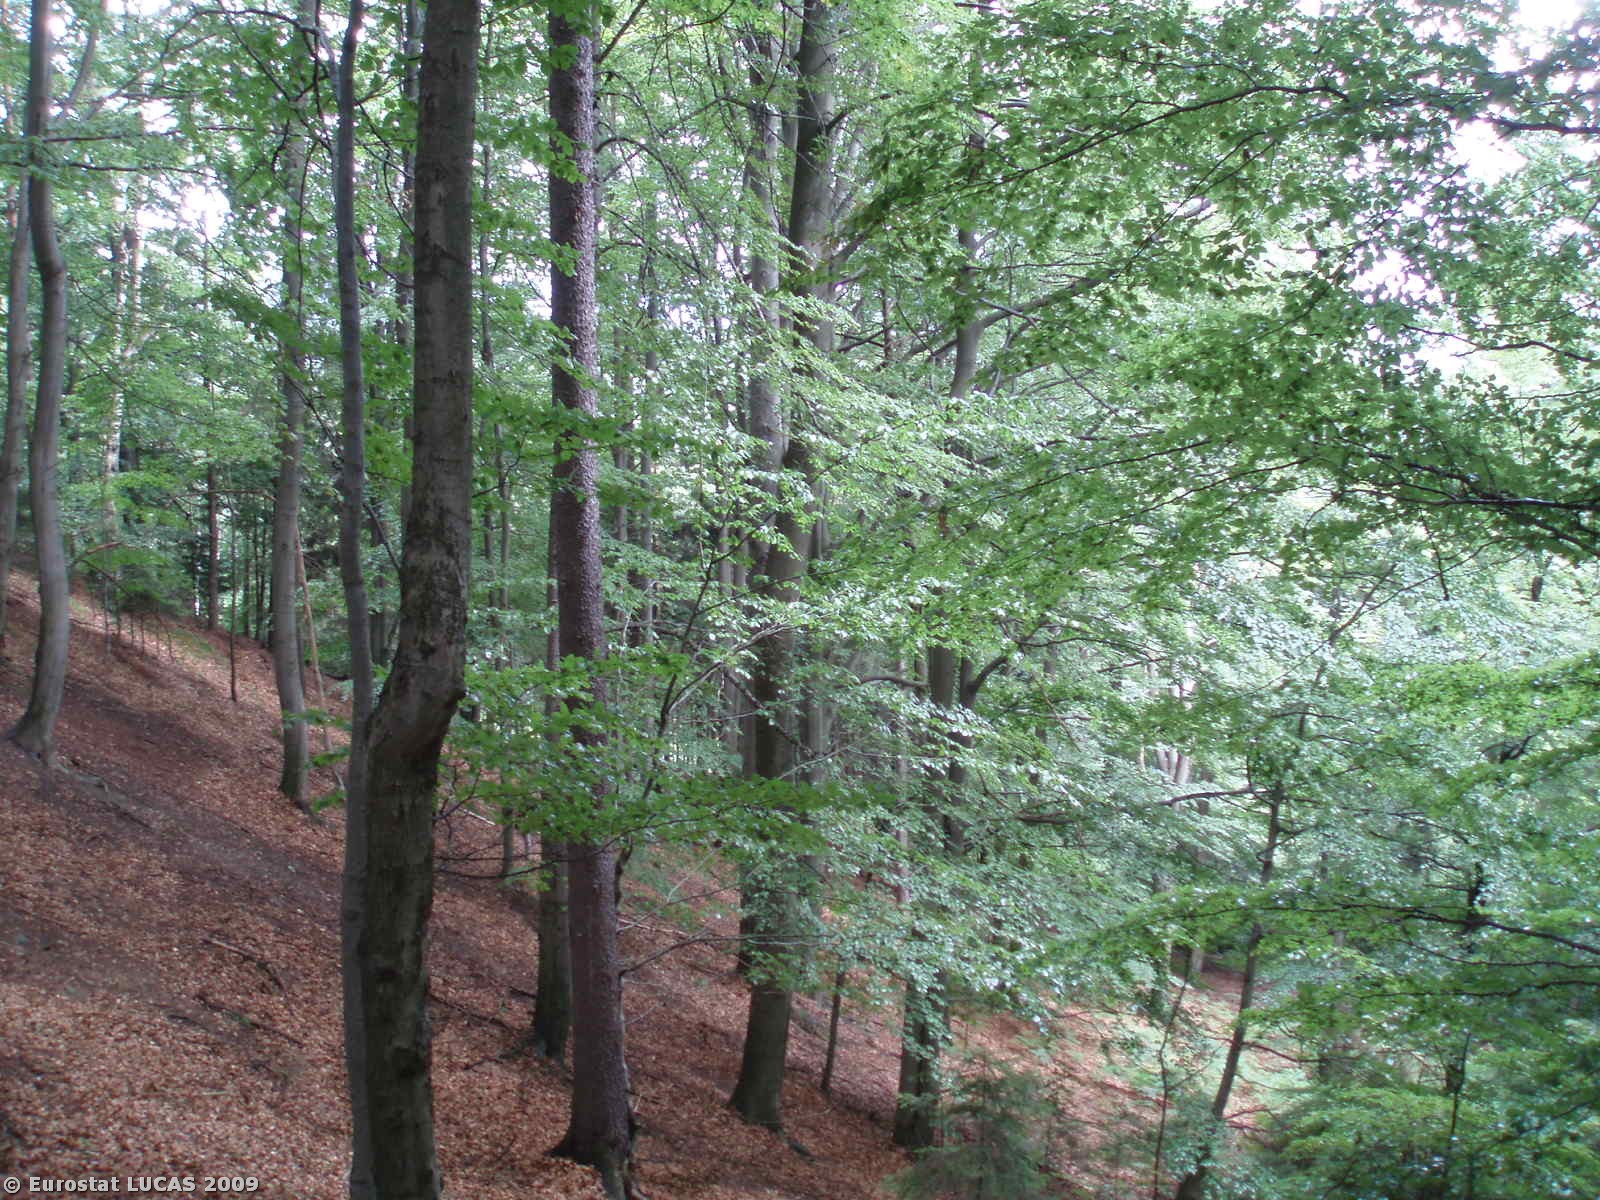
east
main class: Woodland
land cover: Broadleaved woodland
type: beech forest
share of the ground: > 75 %
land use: Forestry
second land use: Nature reserves
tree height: > 5 m
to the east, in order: Broadleaved woodland; Mixed woodland; Coniferous woodland; Tracks; Mixed woodland; Rivers and streams; Mixed woodland; Broadleaved woodland; Tracks; Broadleaved woodland
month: July
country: CZ
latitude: 50.8055
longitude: 14.7561
